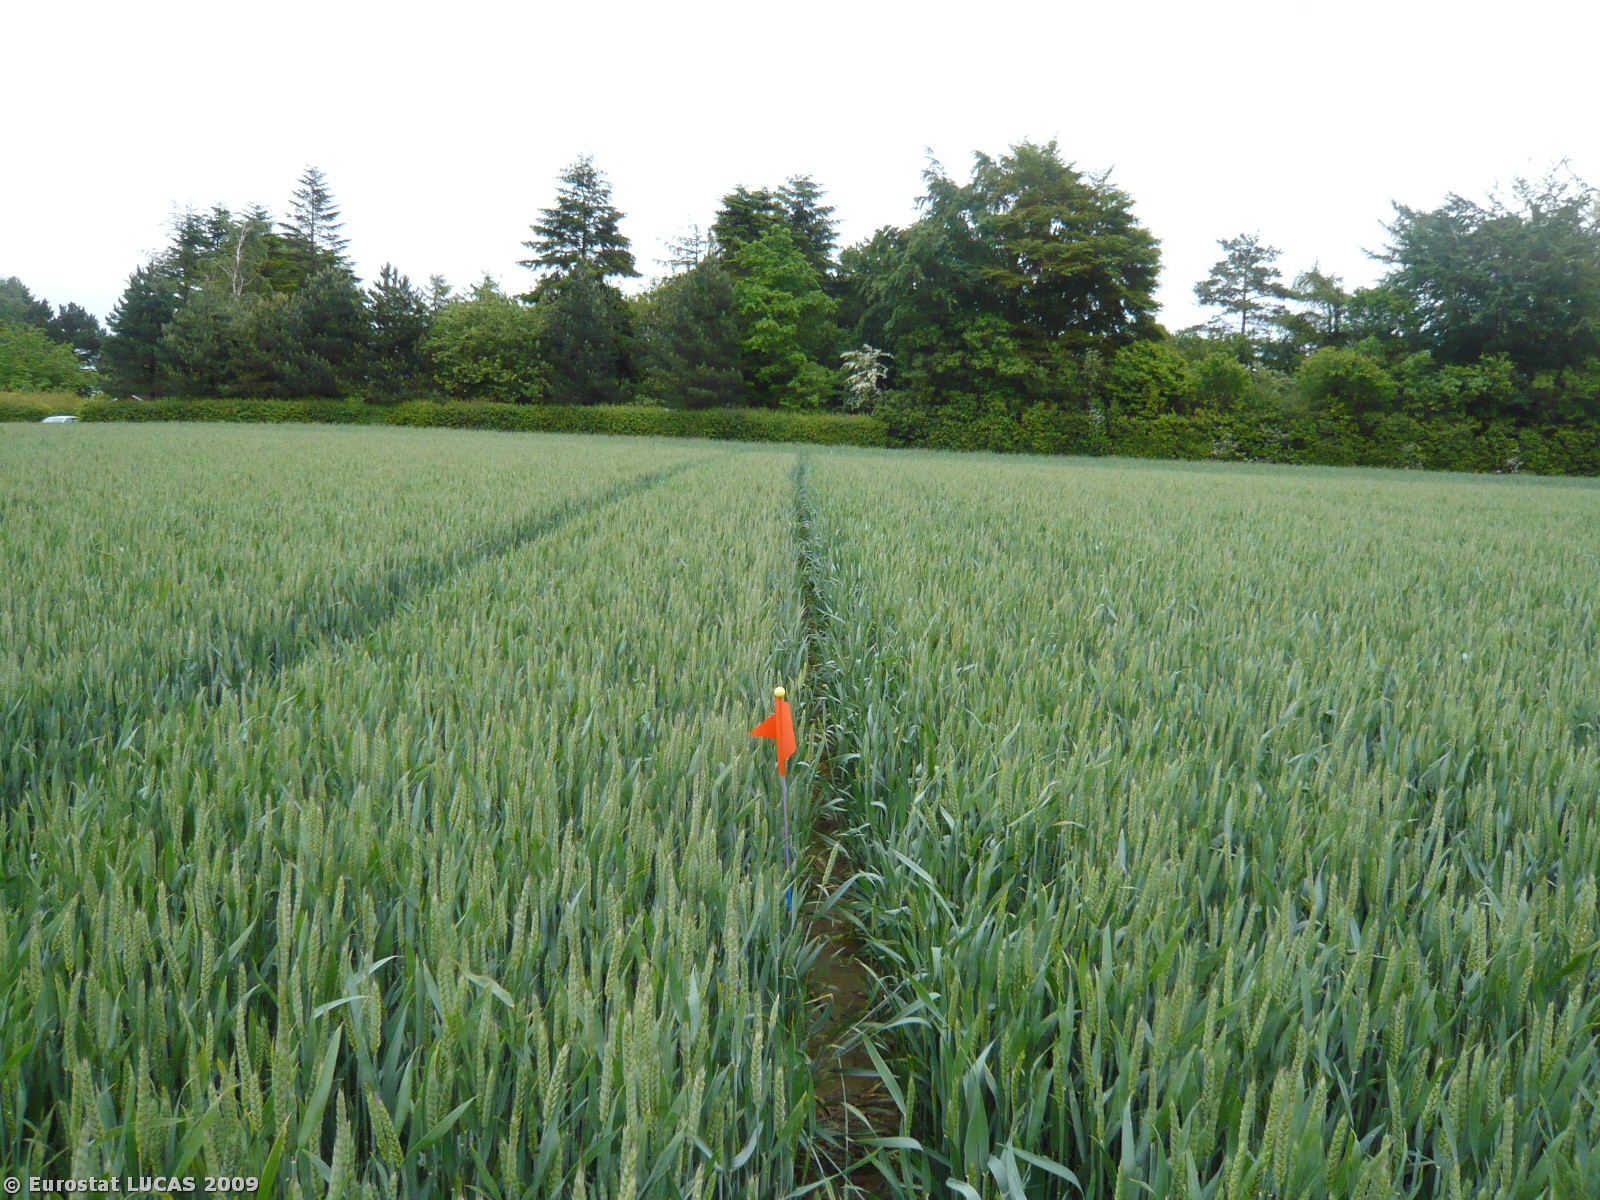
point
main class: Cropland
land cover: Common wheat
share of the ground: > 75 %
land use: Agriculture (excluding fallow land and kitchen gardens)
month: June
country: DK
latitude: 54.7512
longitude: 12.0341
